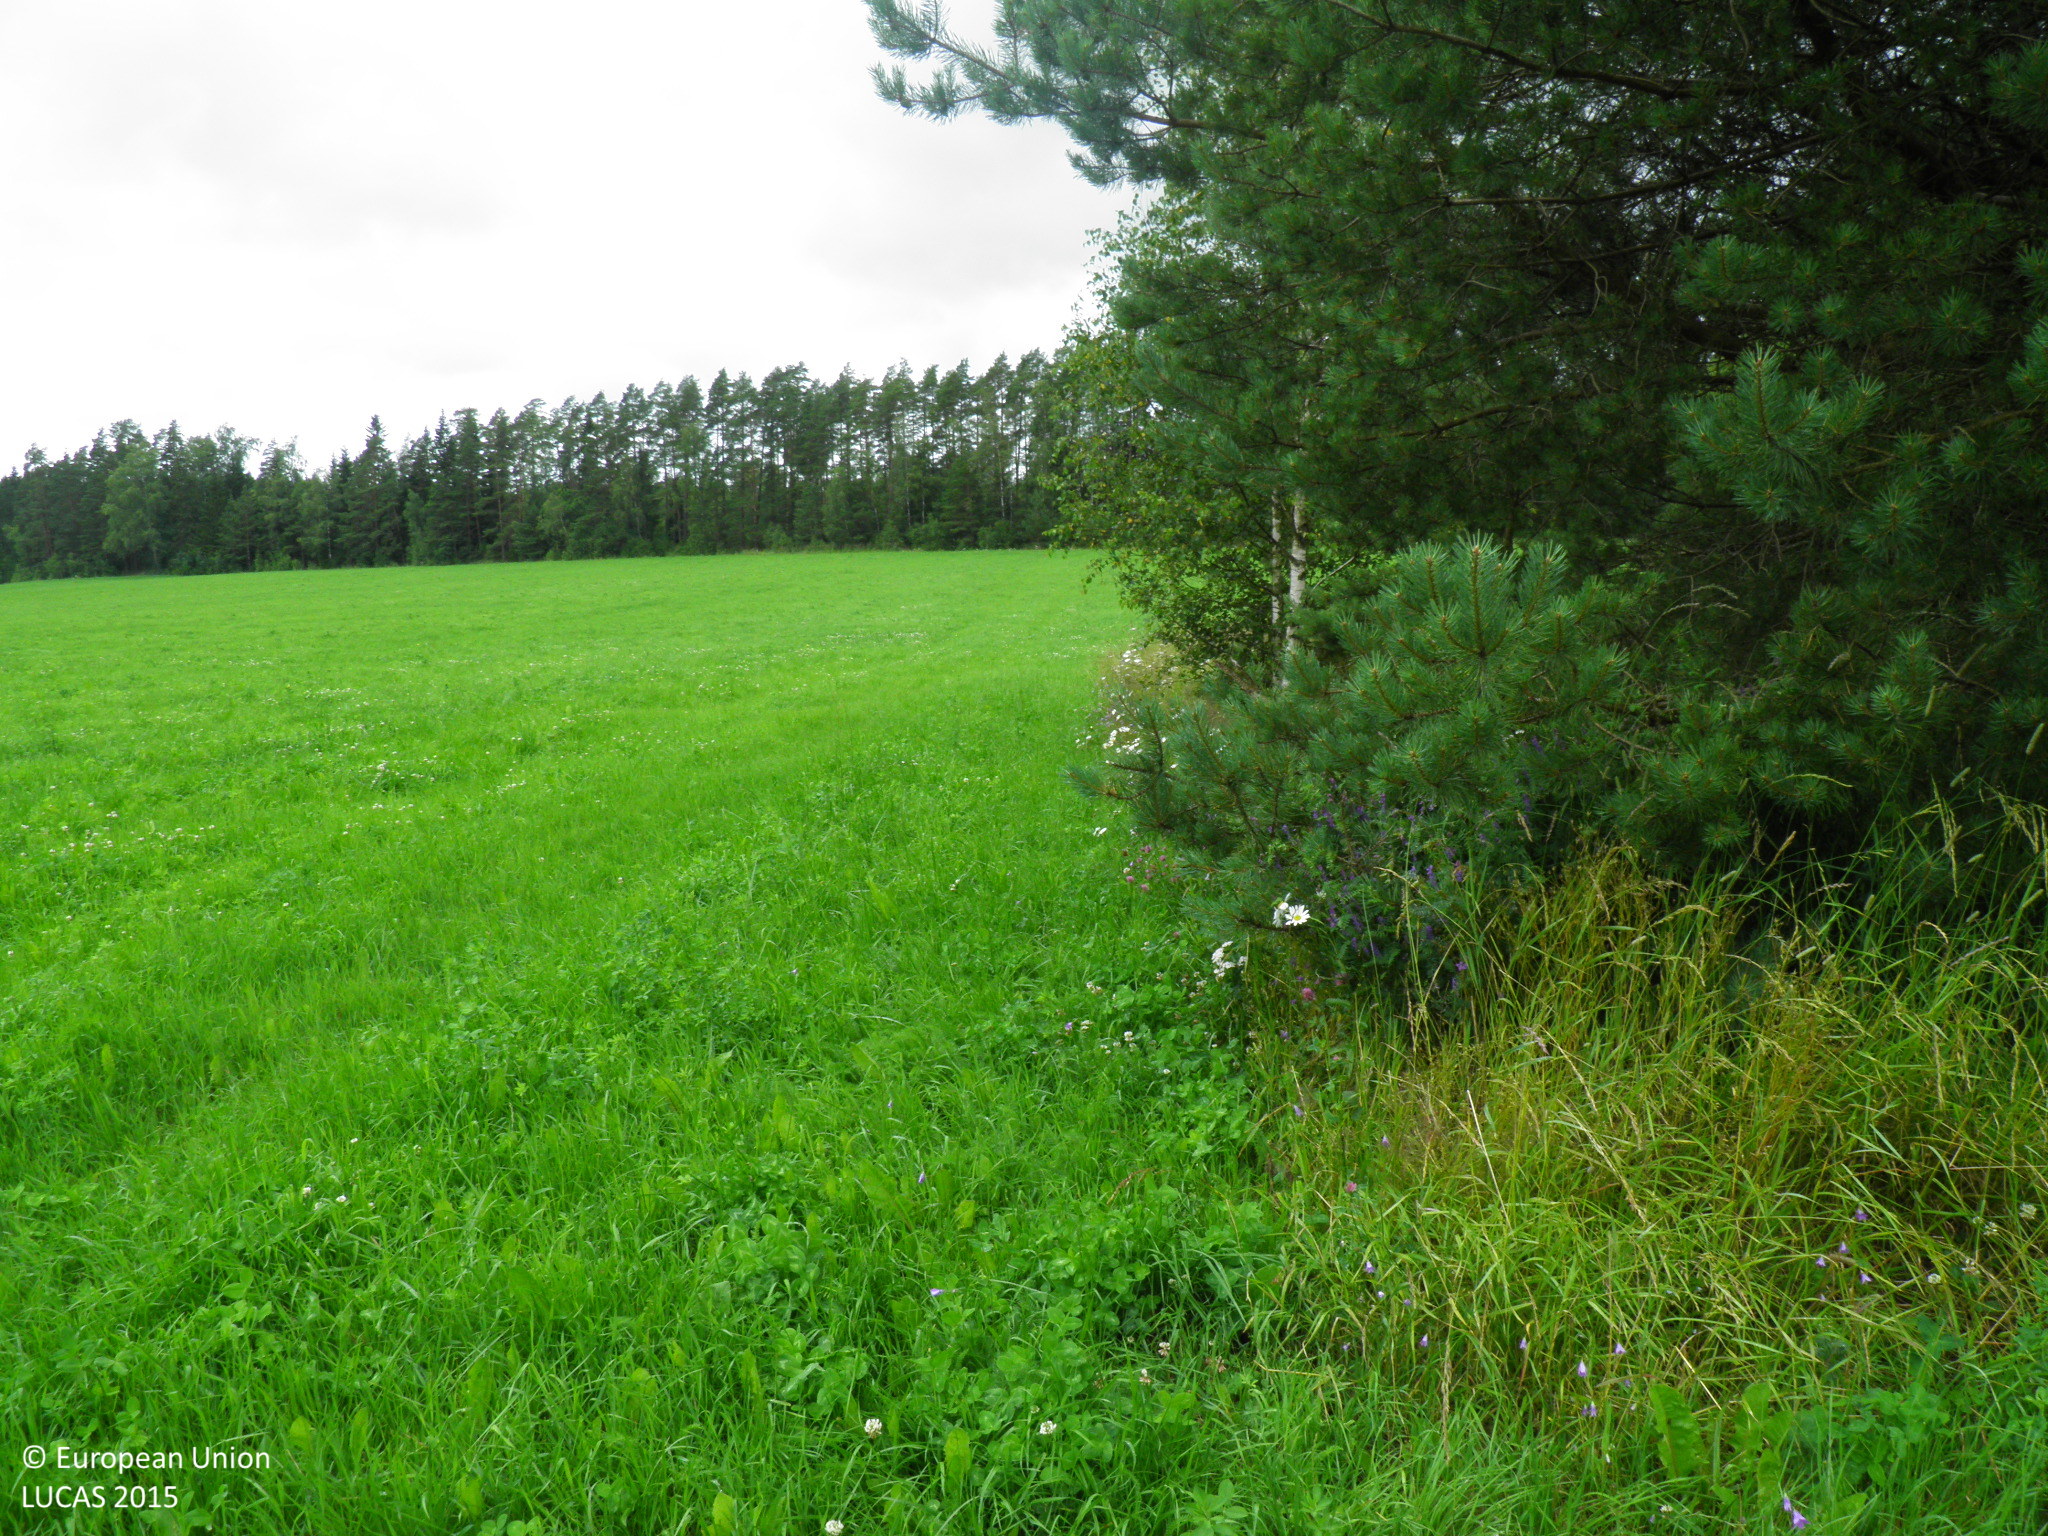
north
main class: Cropland
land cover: Temporary grasslands
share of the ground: > 75 %
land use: Agriculture (excluding fallow land and kitchen gardens)
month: July
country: FI
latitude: 60.6512
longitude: 21.5614
